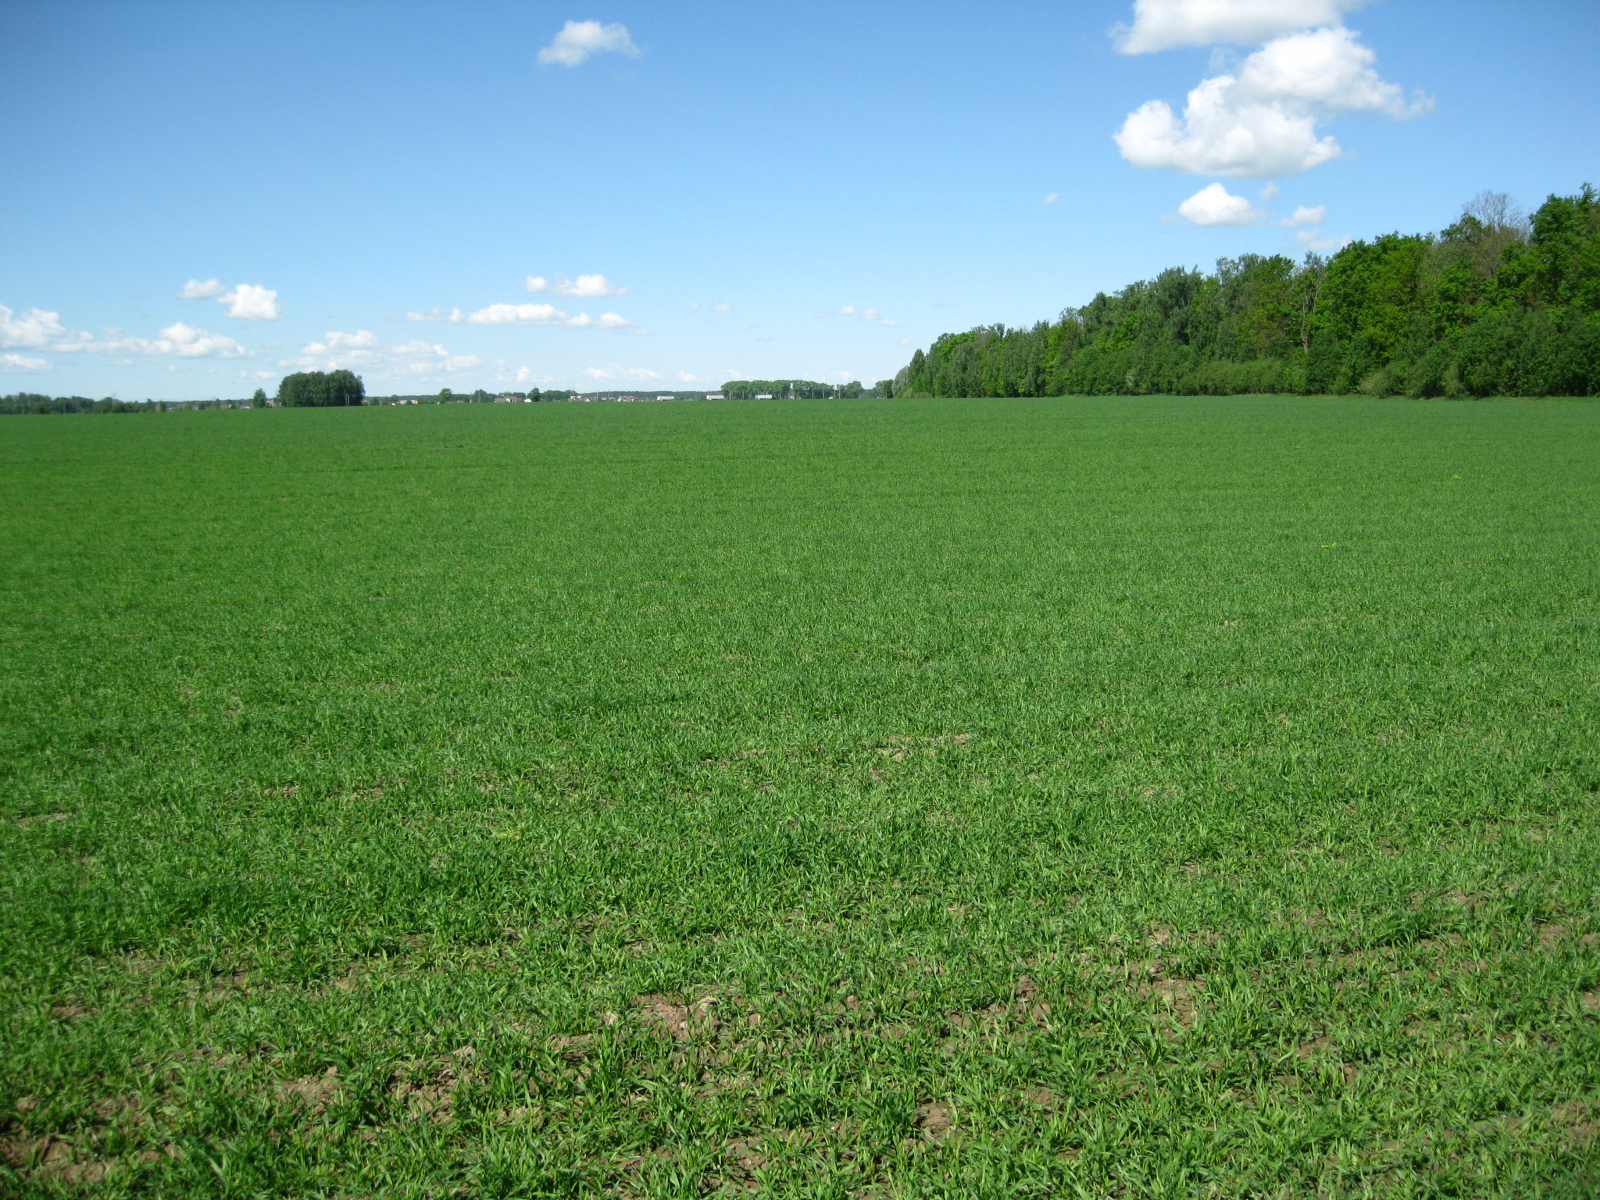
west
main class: Cropland
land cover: Barley
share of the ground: 50 - 75 %
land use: Agriculture (excluding fallow land and kitchen gardens)
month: May
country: LT
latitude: 55.7797
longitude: 24.3333
